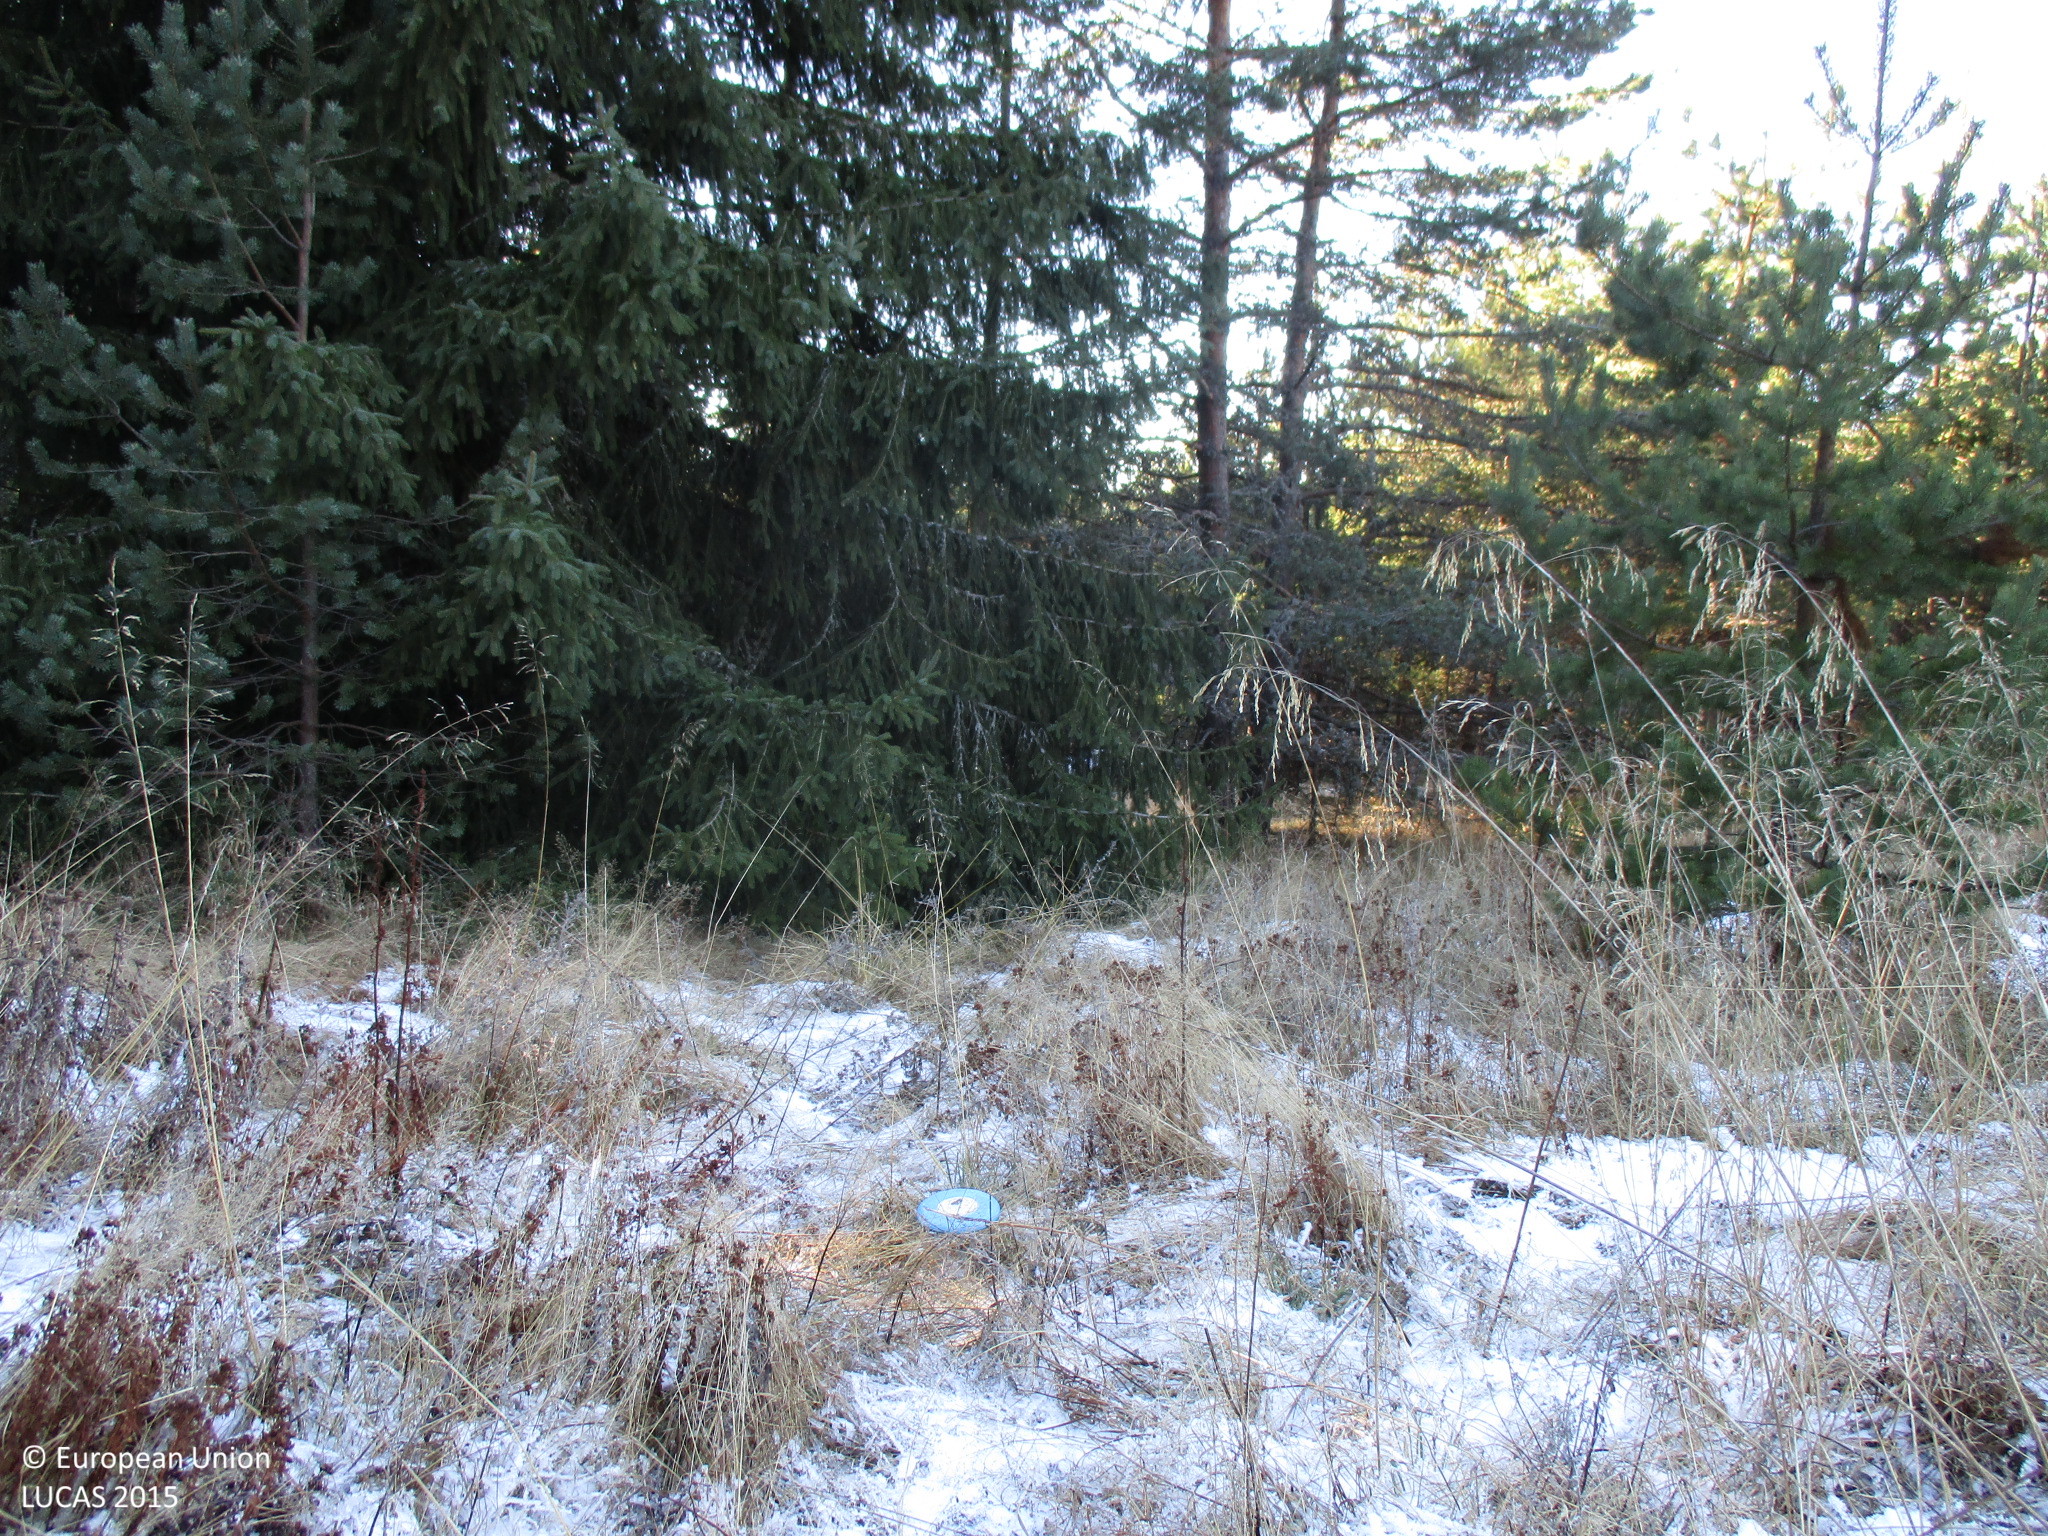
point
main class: Woodland
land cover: Spruce dominated coniferous woodland
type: hemiboreal forest and nemoral coniferous forest and mixed broadleaved-coniferous forest
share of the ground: 25 - 50 %
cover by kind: herbaceous plants 75 %, coniferous forest trees 25 %
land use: Forestry
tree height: > 5 m
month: December
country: BG
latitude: 41.9337
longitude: 24.6277
